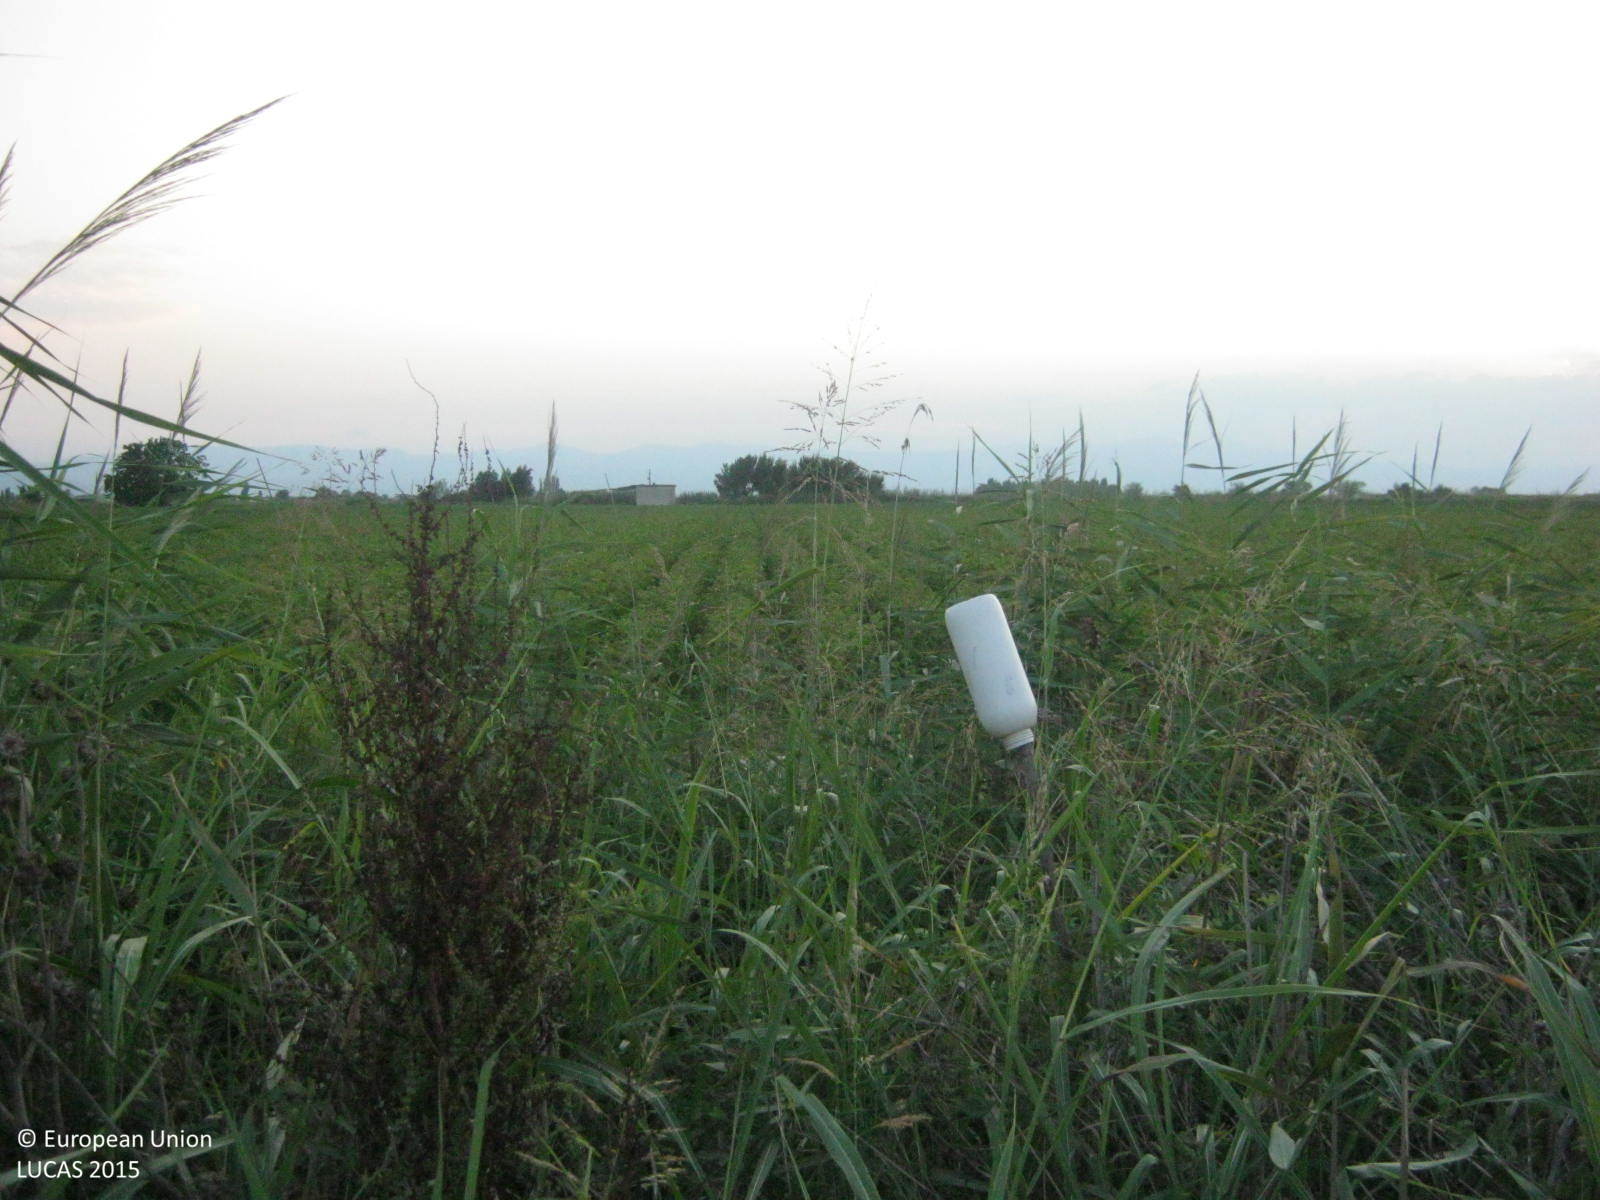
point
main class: Cropland
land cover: Cotton
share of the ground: > 75 %
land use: Agriculture (excluding fallow land and kitchen gardens)
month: August
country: GR
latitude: 40.6077
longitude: 22.5659
